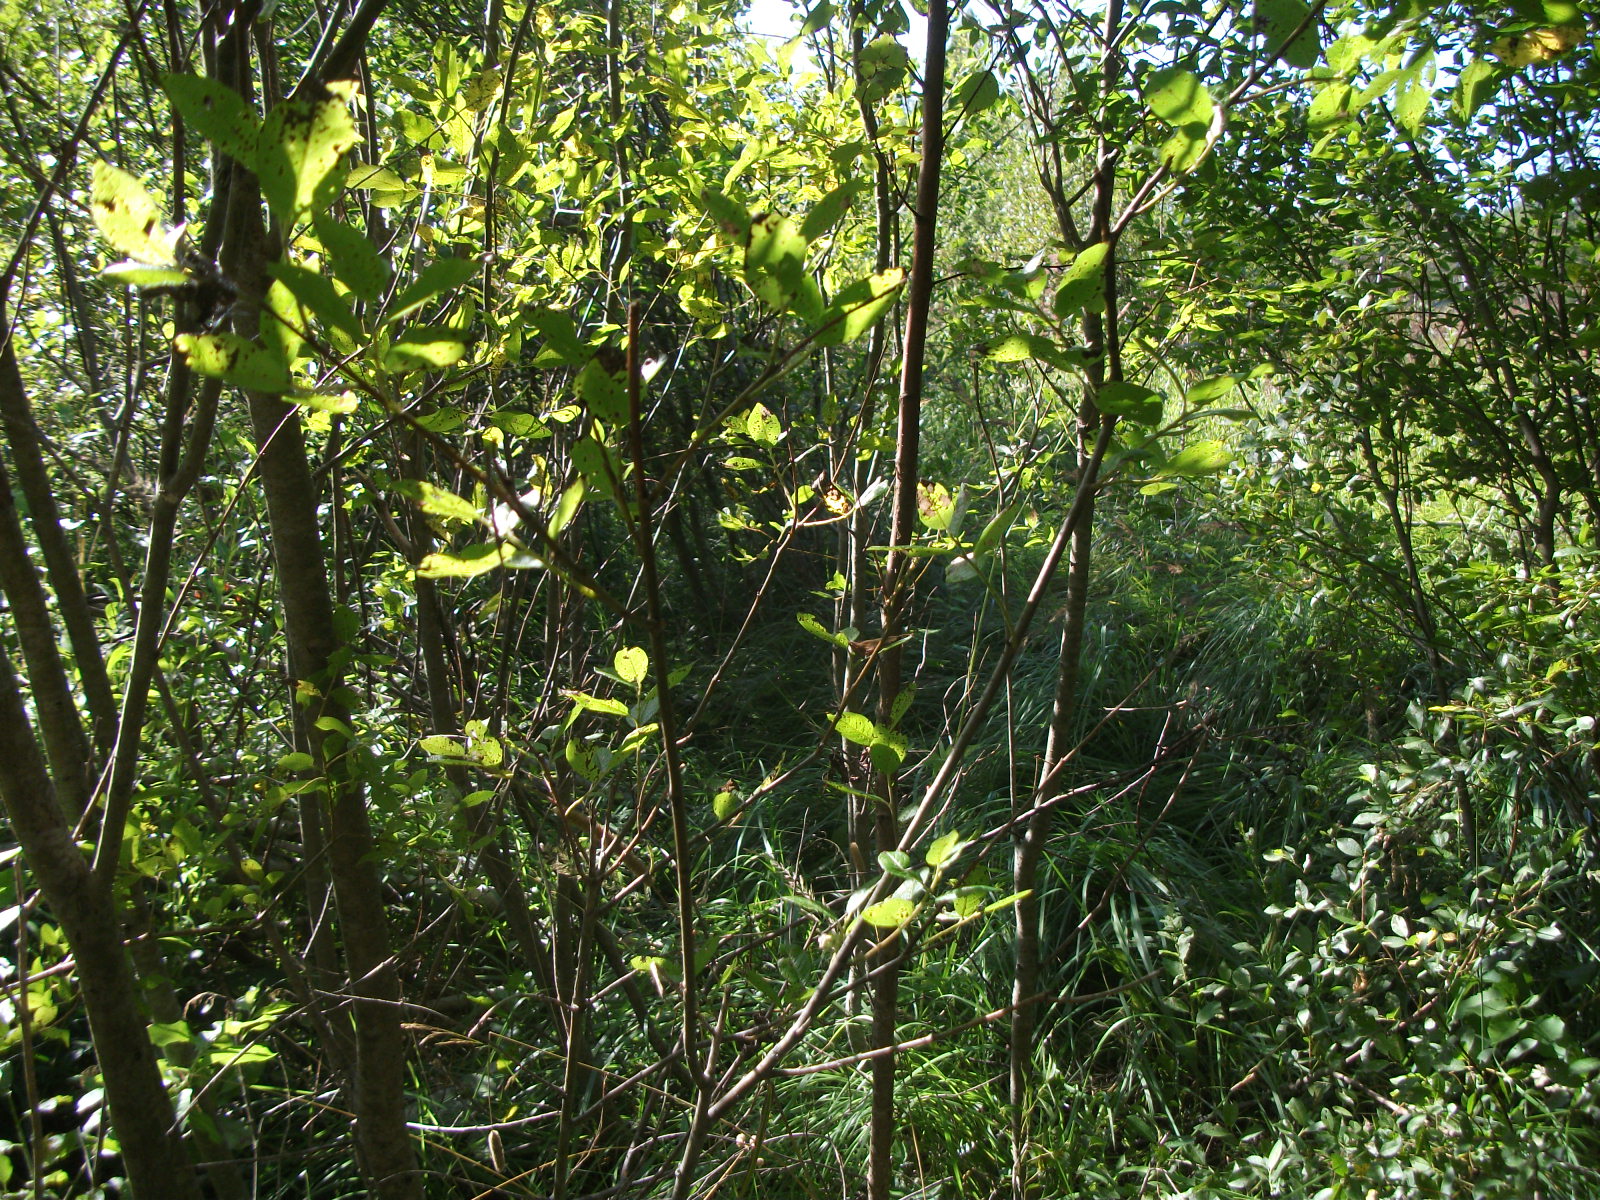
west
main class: Woodland
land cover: Broadleaved woodland
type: non-riverine alder, birch or aspen forest
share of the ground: 50 - 75 %
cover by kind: broadleaved forest trees 50 %, shrubs 45 %, herbaceous plants 5 %
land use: Semi-natural and natural areas not in use
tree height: < 5 m
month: August
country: LV
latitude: 56.5411
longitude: 26.0898
